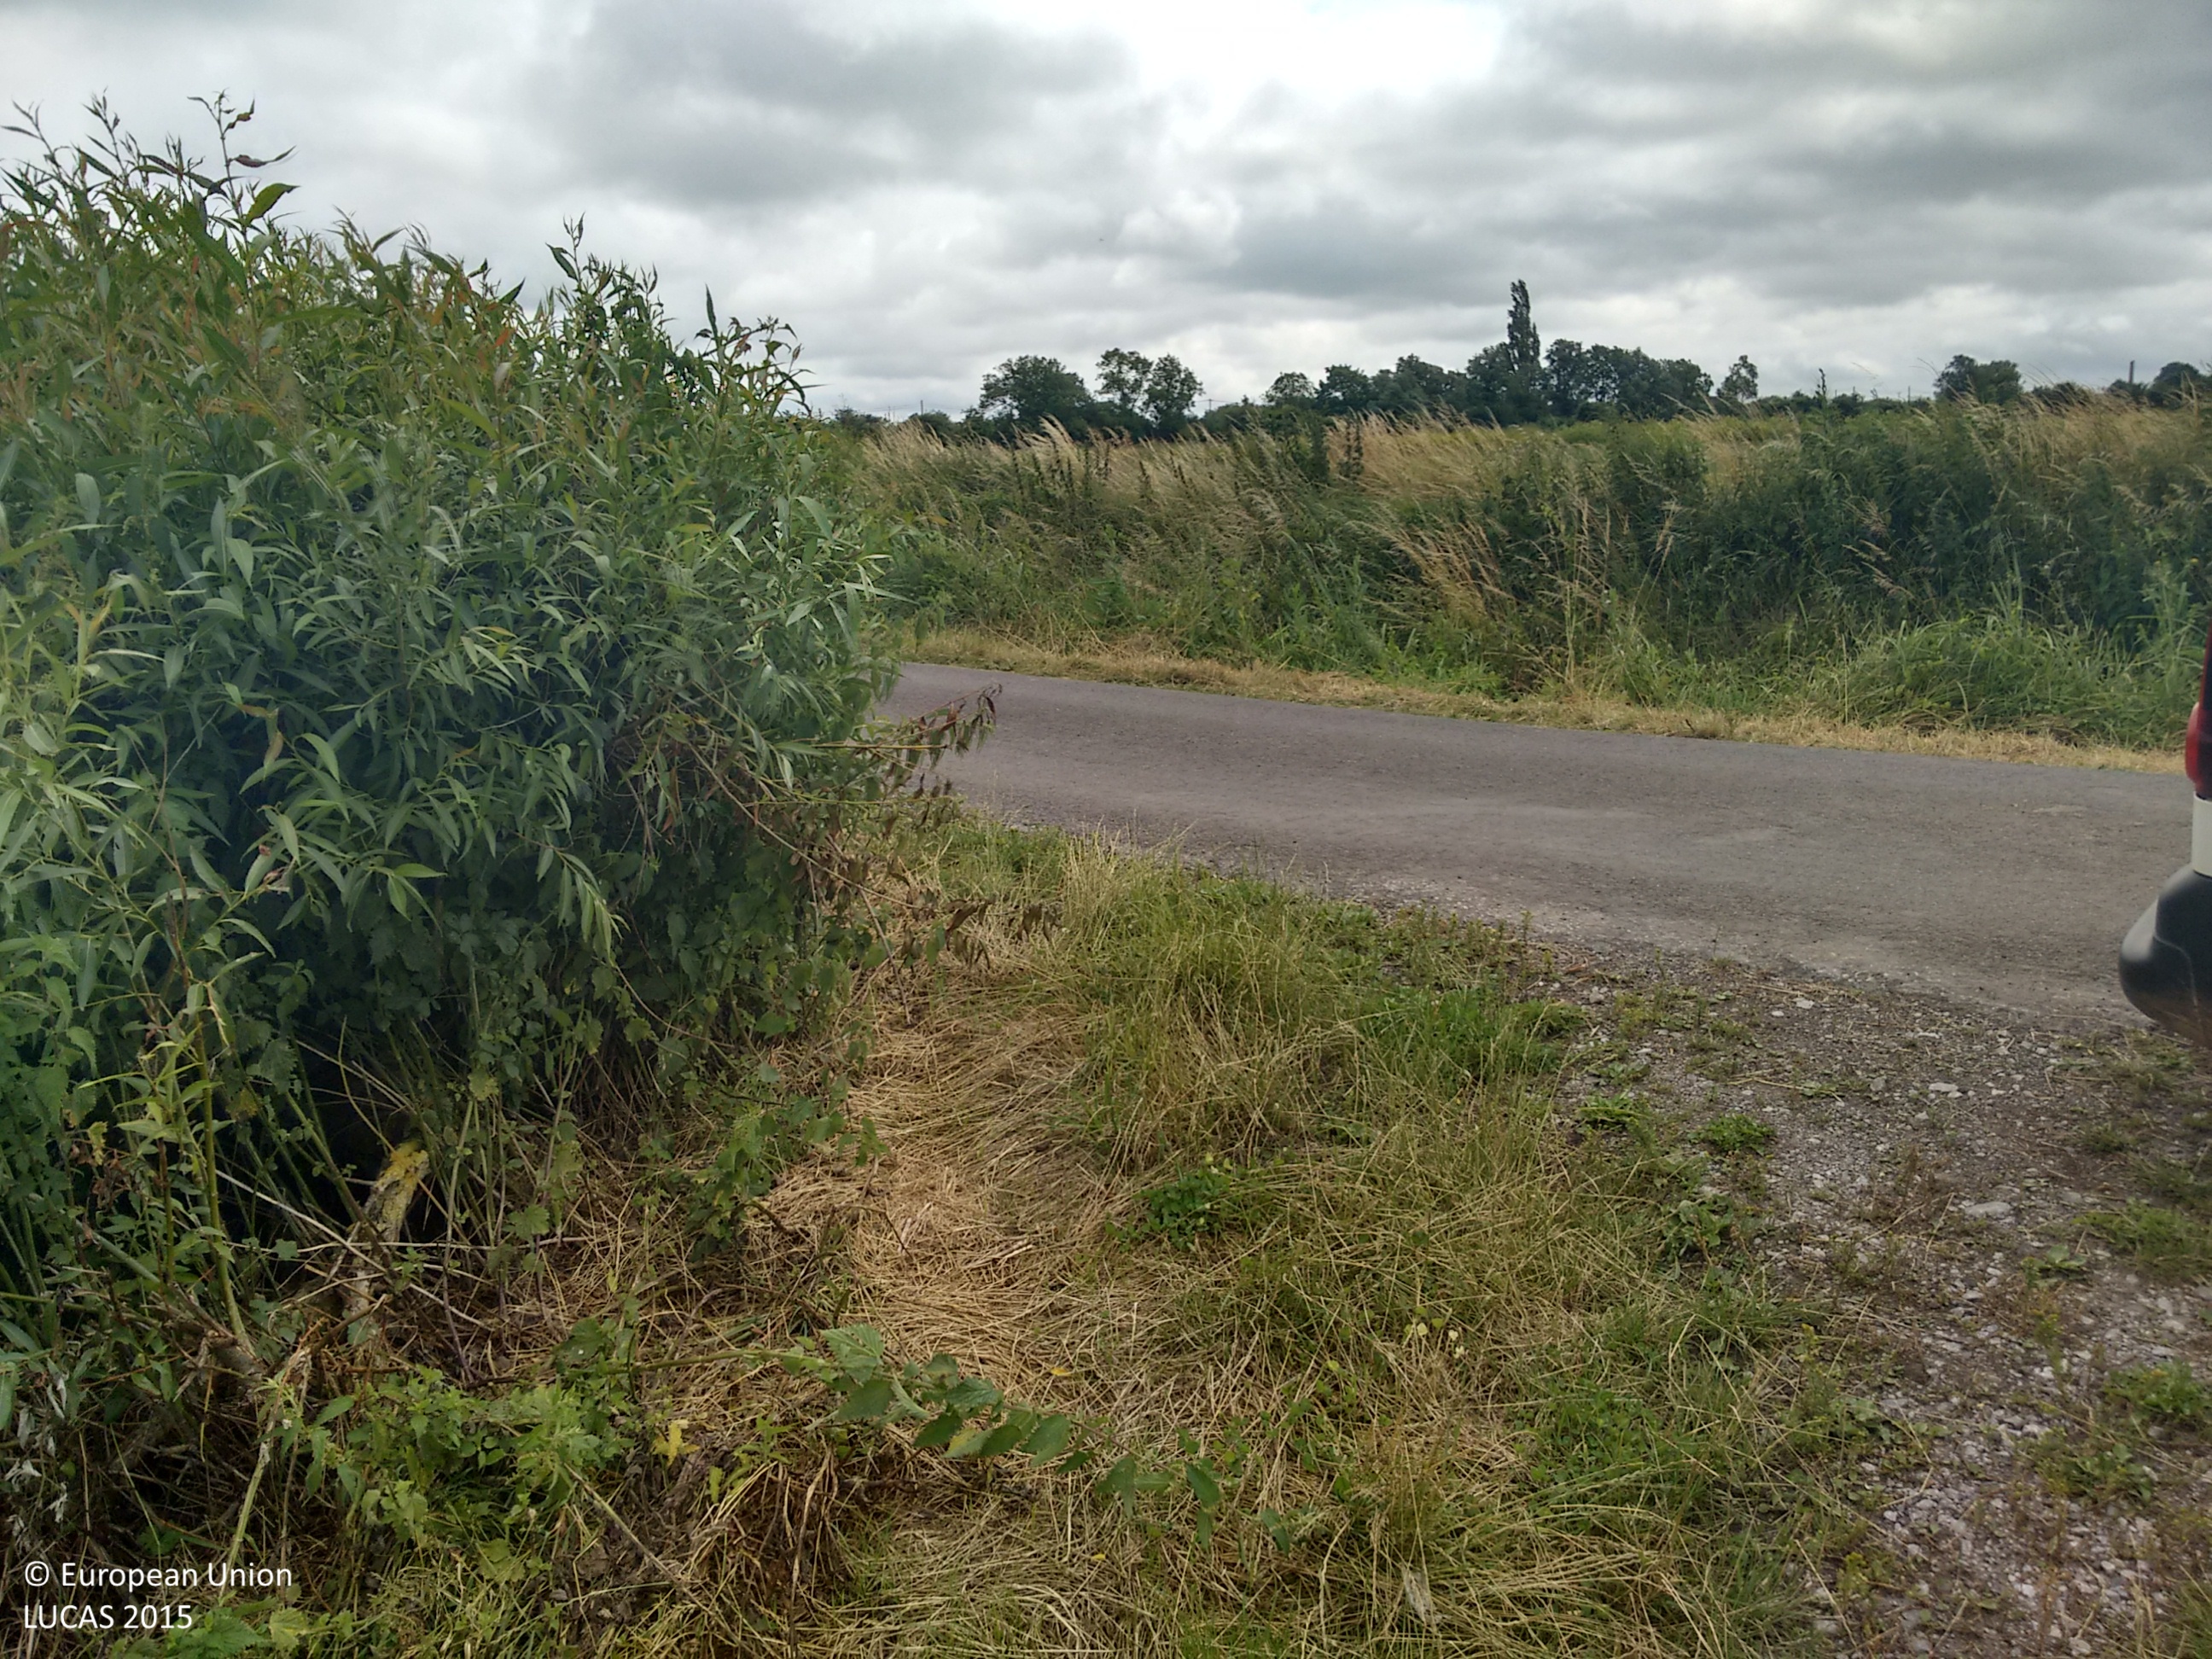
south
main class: Cropland
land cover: Temporary grasslands
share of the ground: > 75 %
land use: Agriculture (excluding fallow land and kitchen gardens)
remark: Harvested field
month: July
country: GB
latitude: 51.1006
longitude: -2.9408
